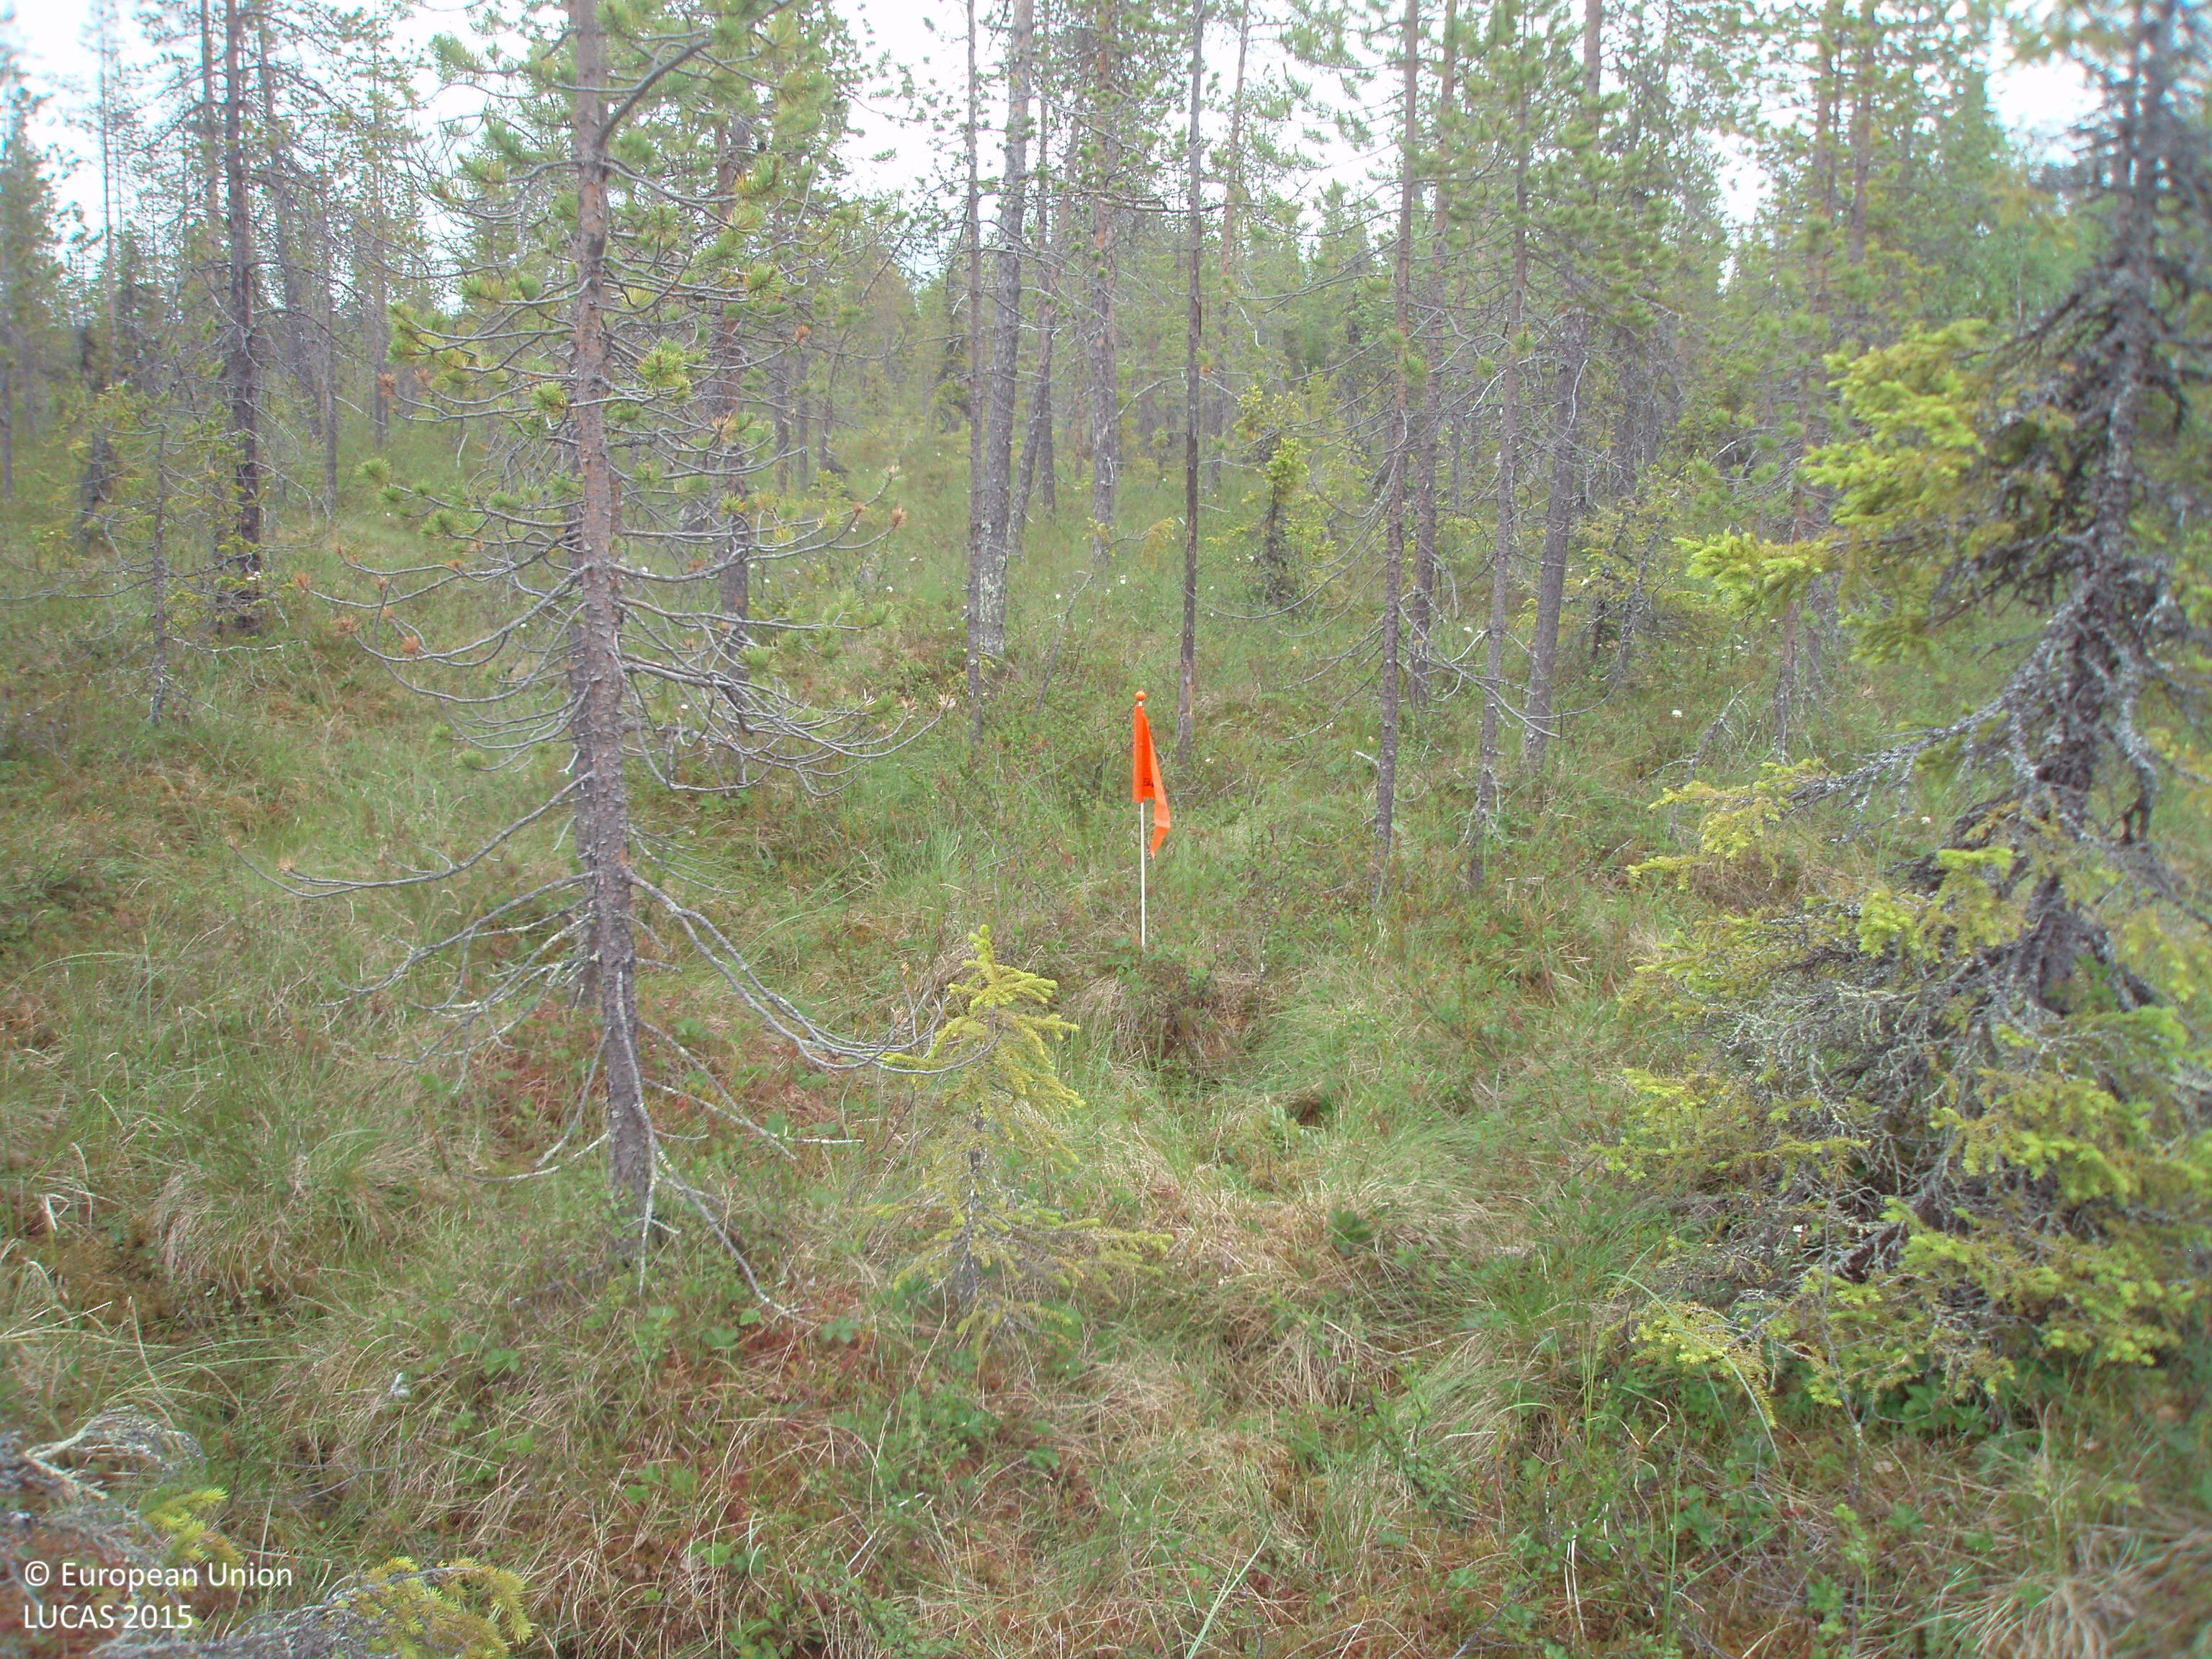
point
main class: Woodland
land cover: Pine dominated coniferous woodland
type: mire and swamp forests
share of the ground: 50 - 75 %
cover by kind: coniferous forest trees 55 %, shrubs 40 %, broadleaved forest trees 5 %
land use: Forestry
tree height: > 5 m
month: July
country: FI
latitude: 67.7548
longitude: 28.8104
